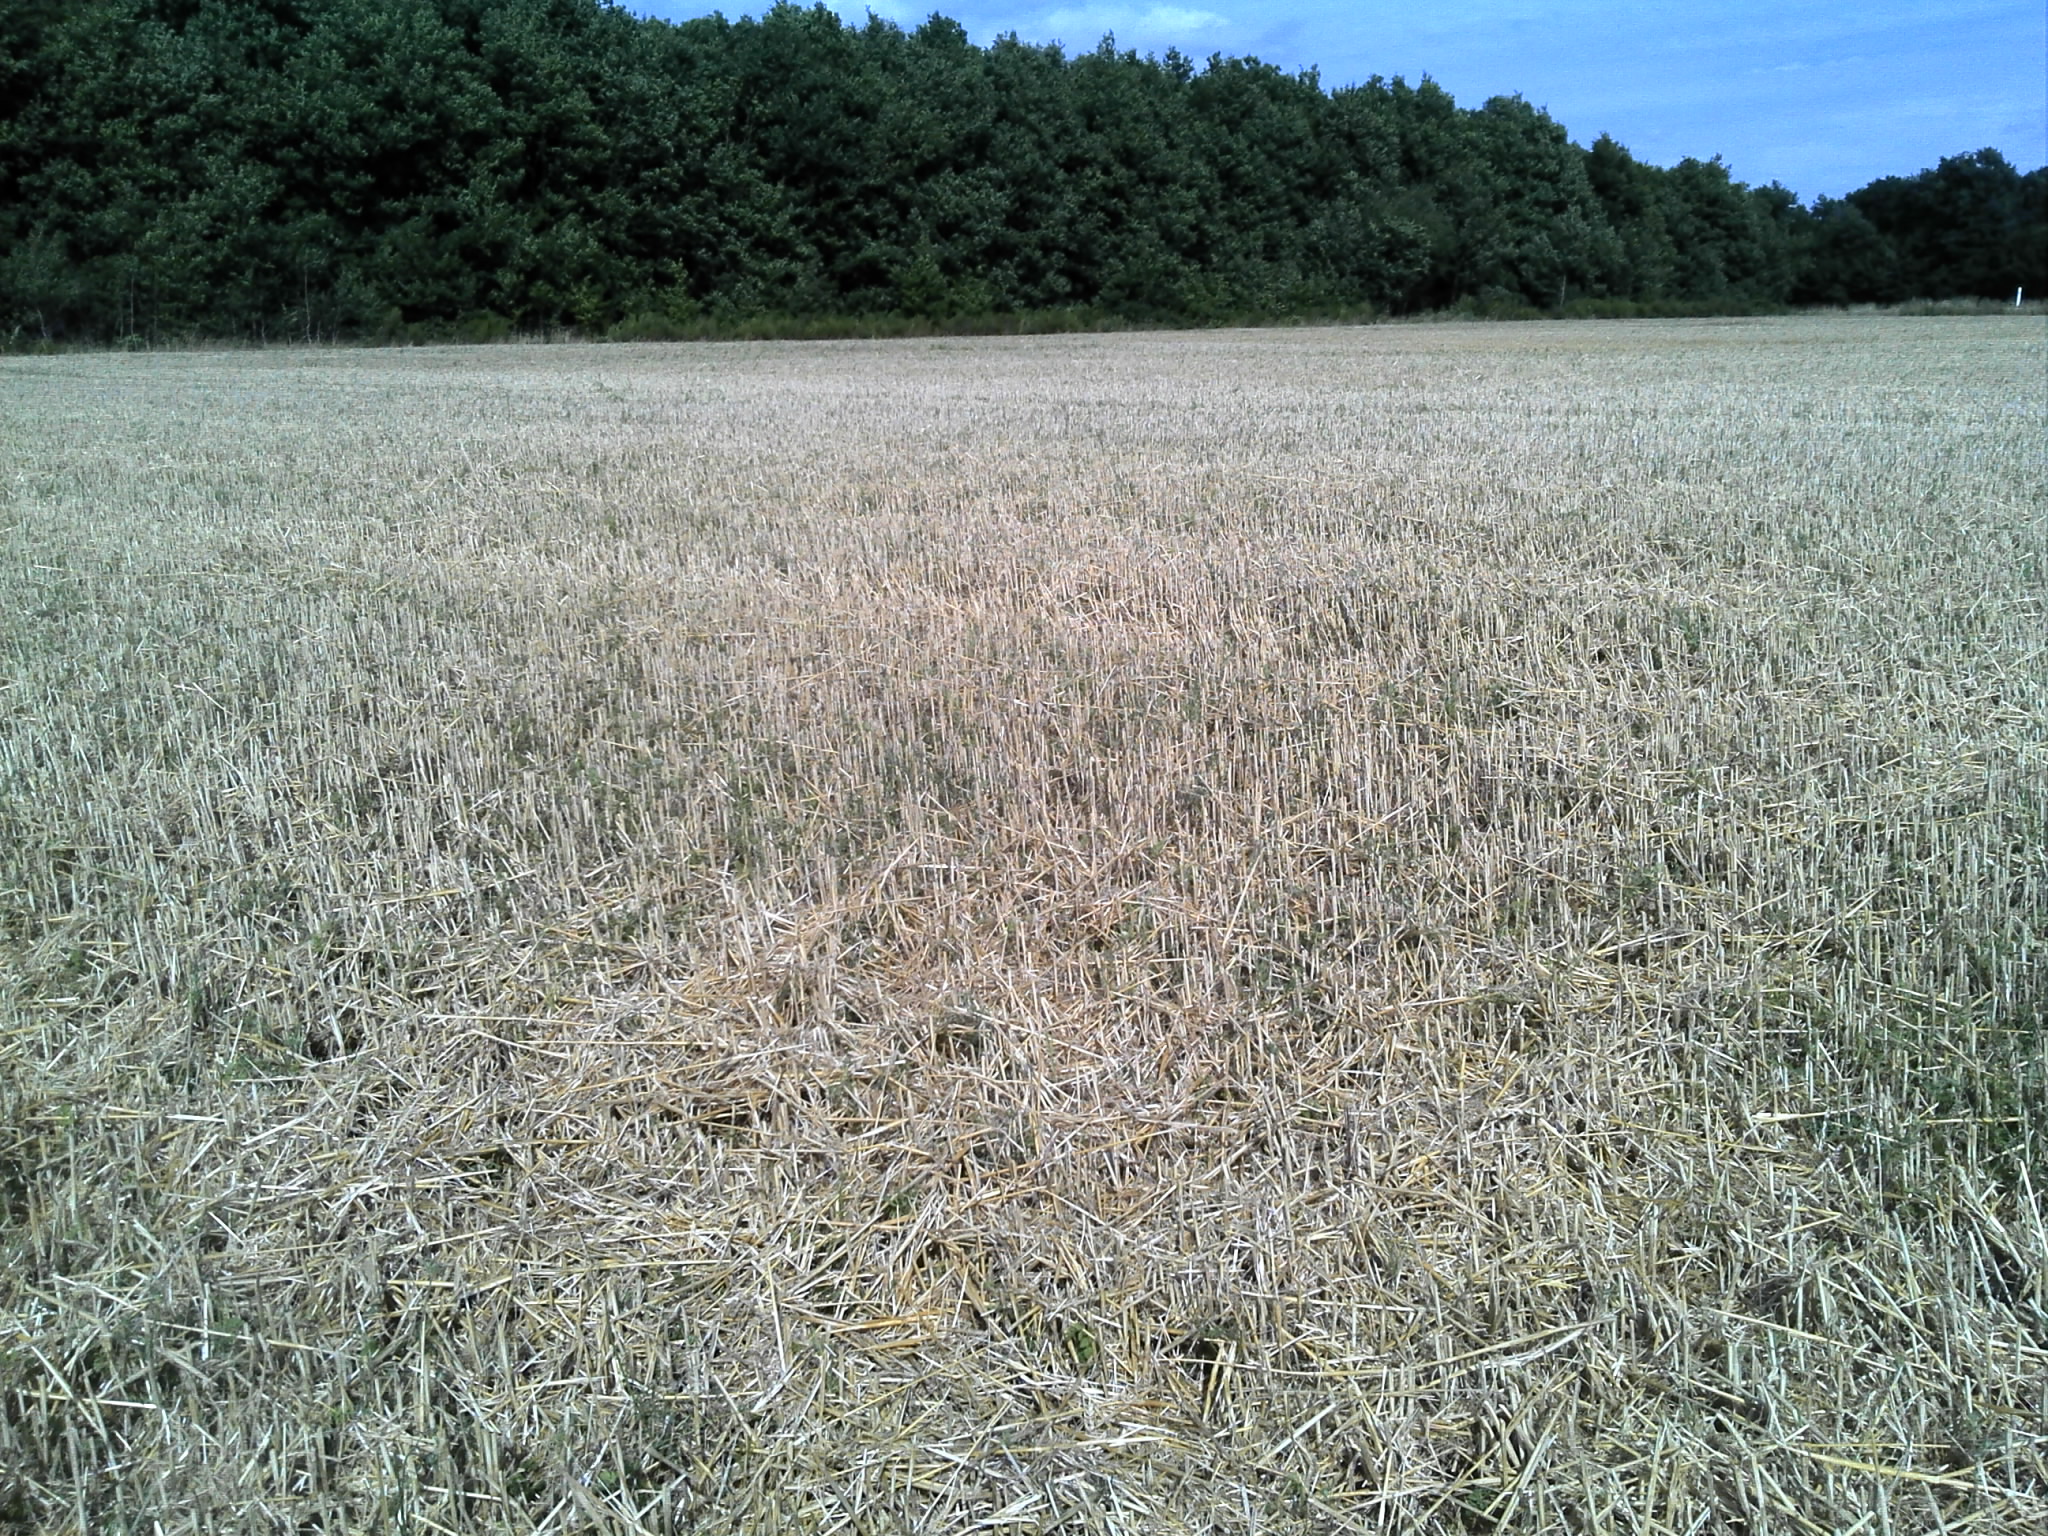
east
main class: Cropland
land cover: Common wheat
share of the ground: > 75 %
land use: Agriculture (excluding fallow land and kitchen gardens)
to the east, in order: Common wheat; Broadleaved woodland; Ditches and canals; Broadleaved woodland; Ditches and canals; Grass margins
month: July
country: FR
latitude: 46.6826
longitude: 1.5040
